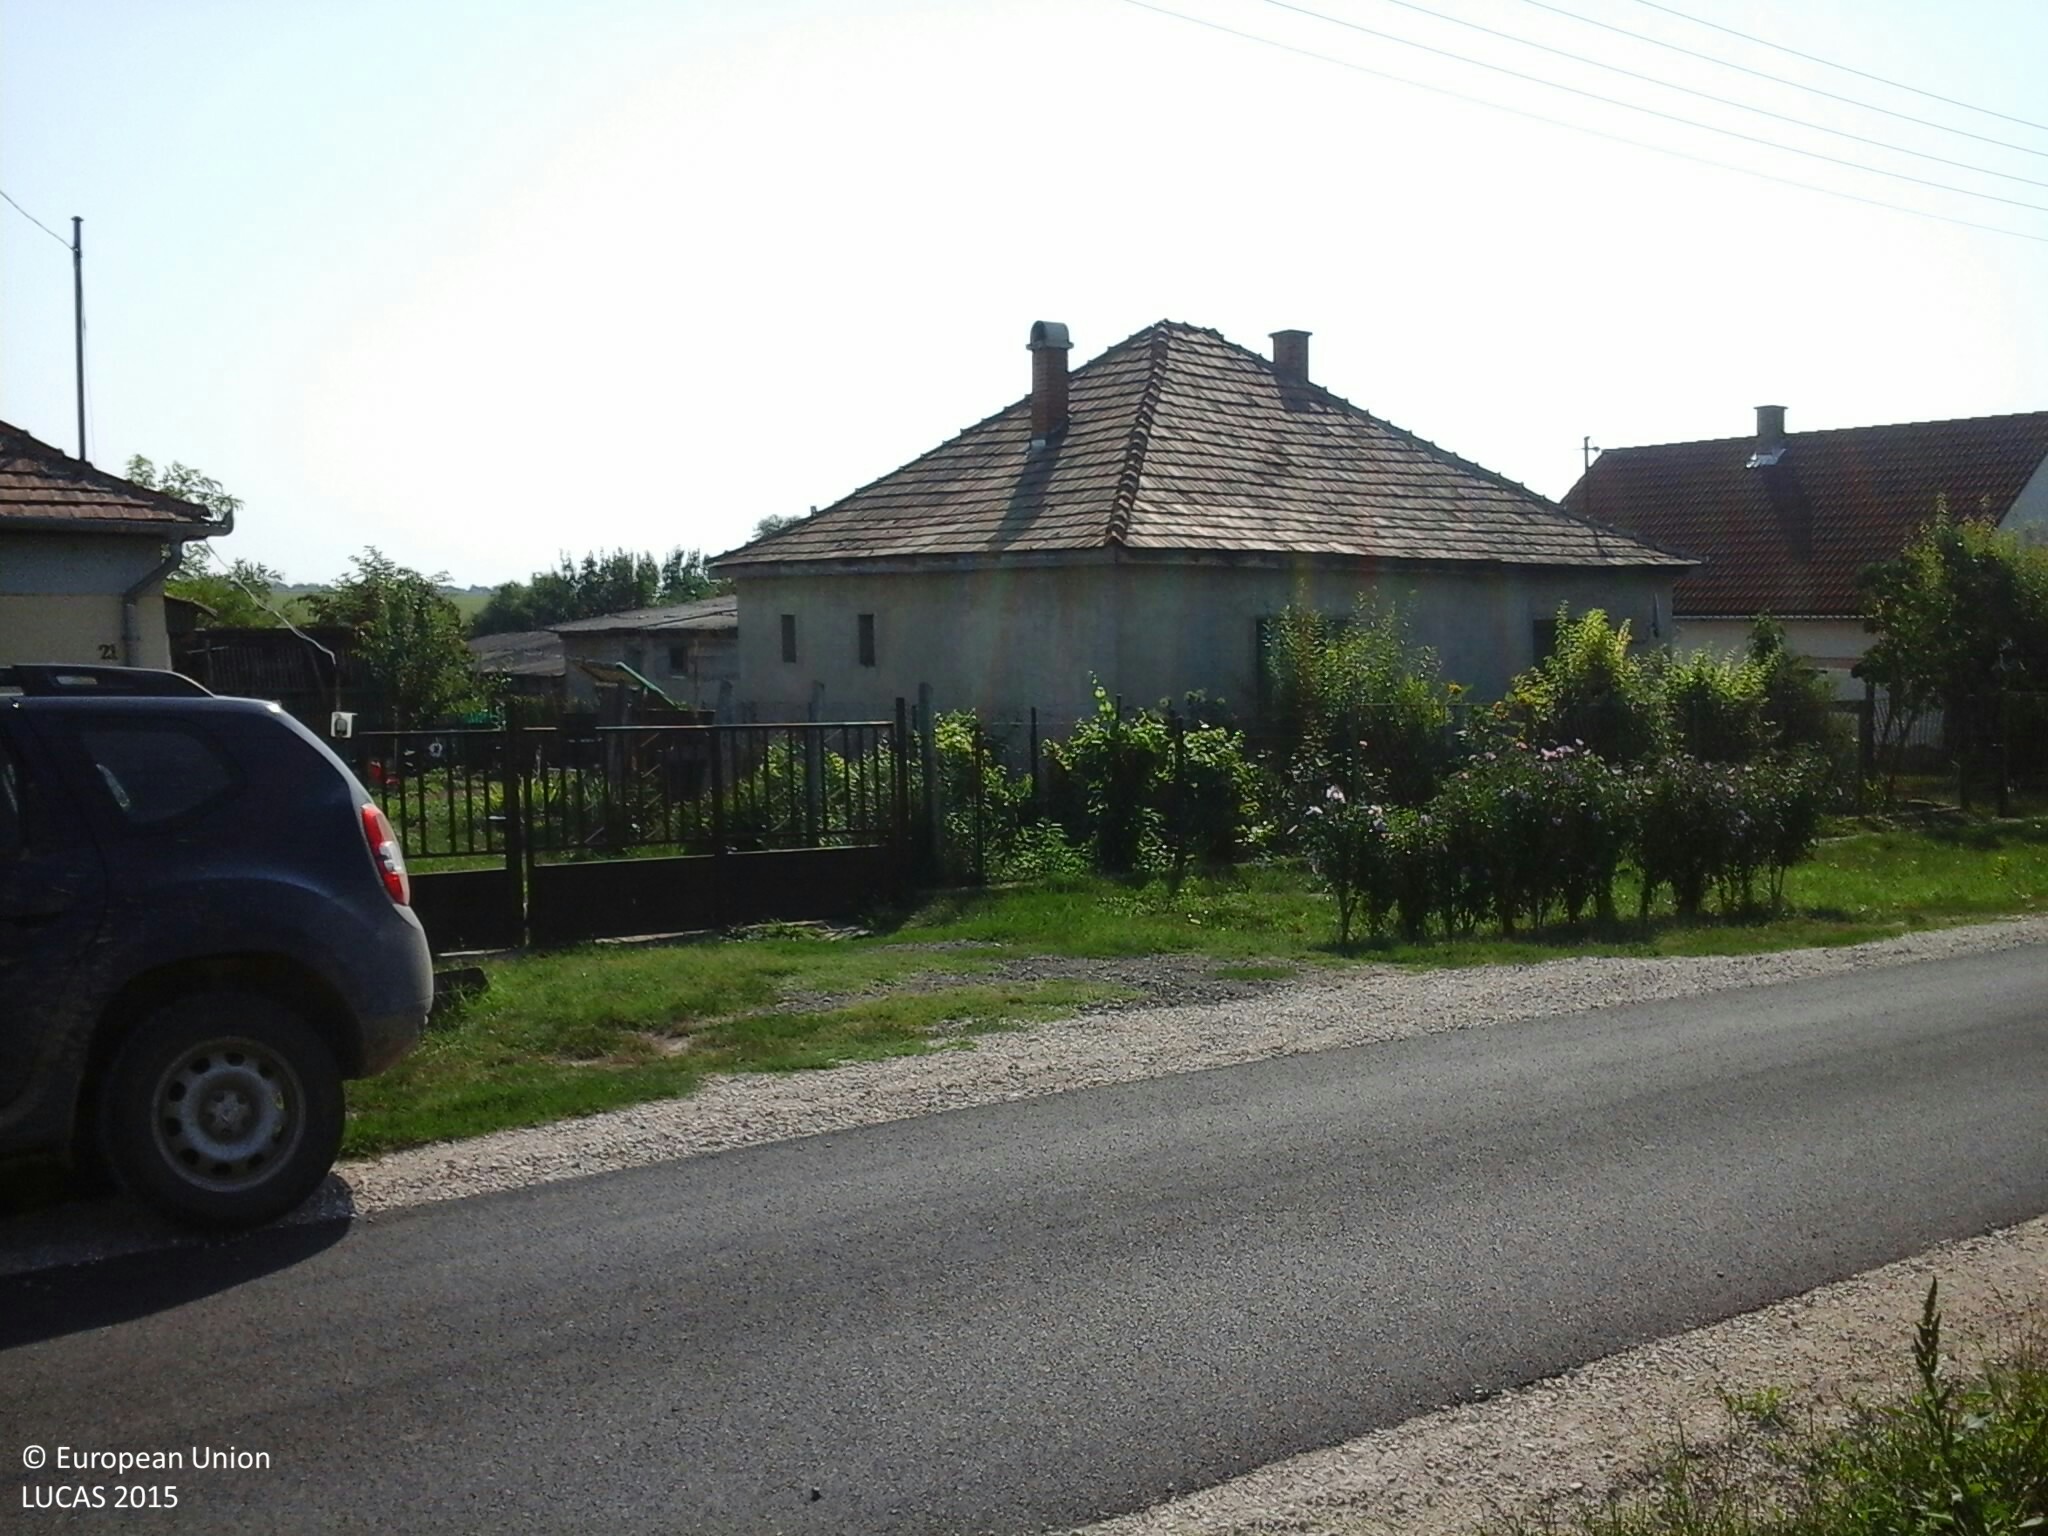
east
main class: Grassland
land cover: Grassland without tree/shrub cover
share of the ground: > 75 %
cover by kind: herbaceous plants 100 %
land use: Residential
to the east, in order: Grassland without tree/shrub cover; Electric lines; Grassland without tree/shrub cover; Artificial constructions in urban areas; Arable land (only in case pi); Grassland with sparse tree/shrub cover; Spontaneously vegetated surfaces; Ditches and canals; Spontaneously vegetated surfaces; Arable land (only in case pi)
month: August
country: HU
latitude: 46.9572
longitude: 18.2232
